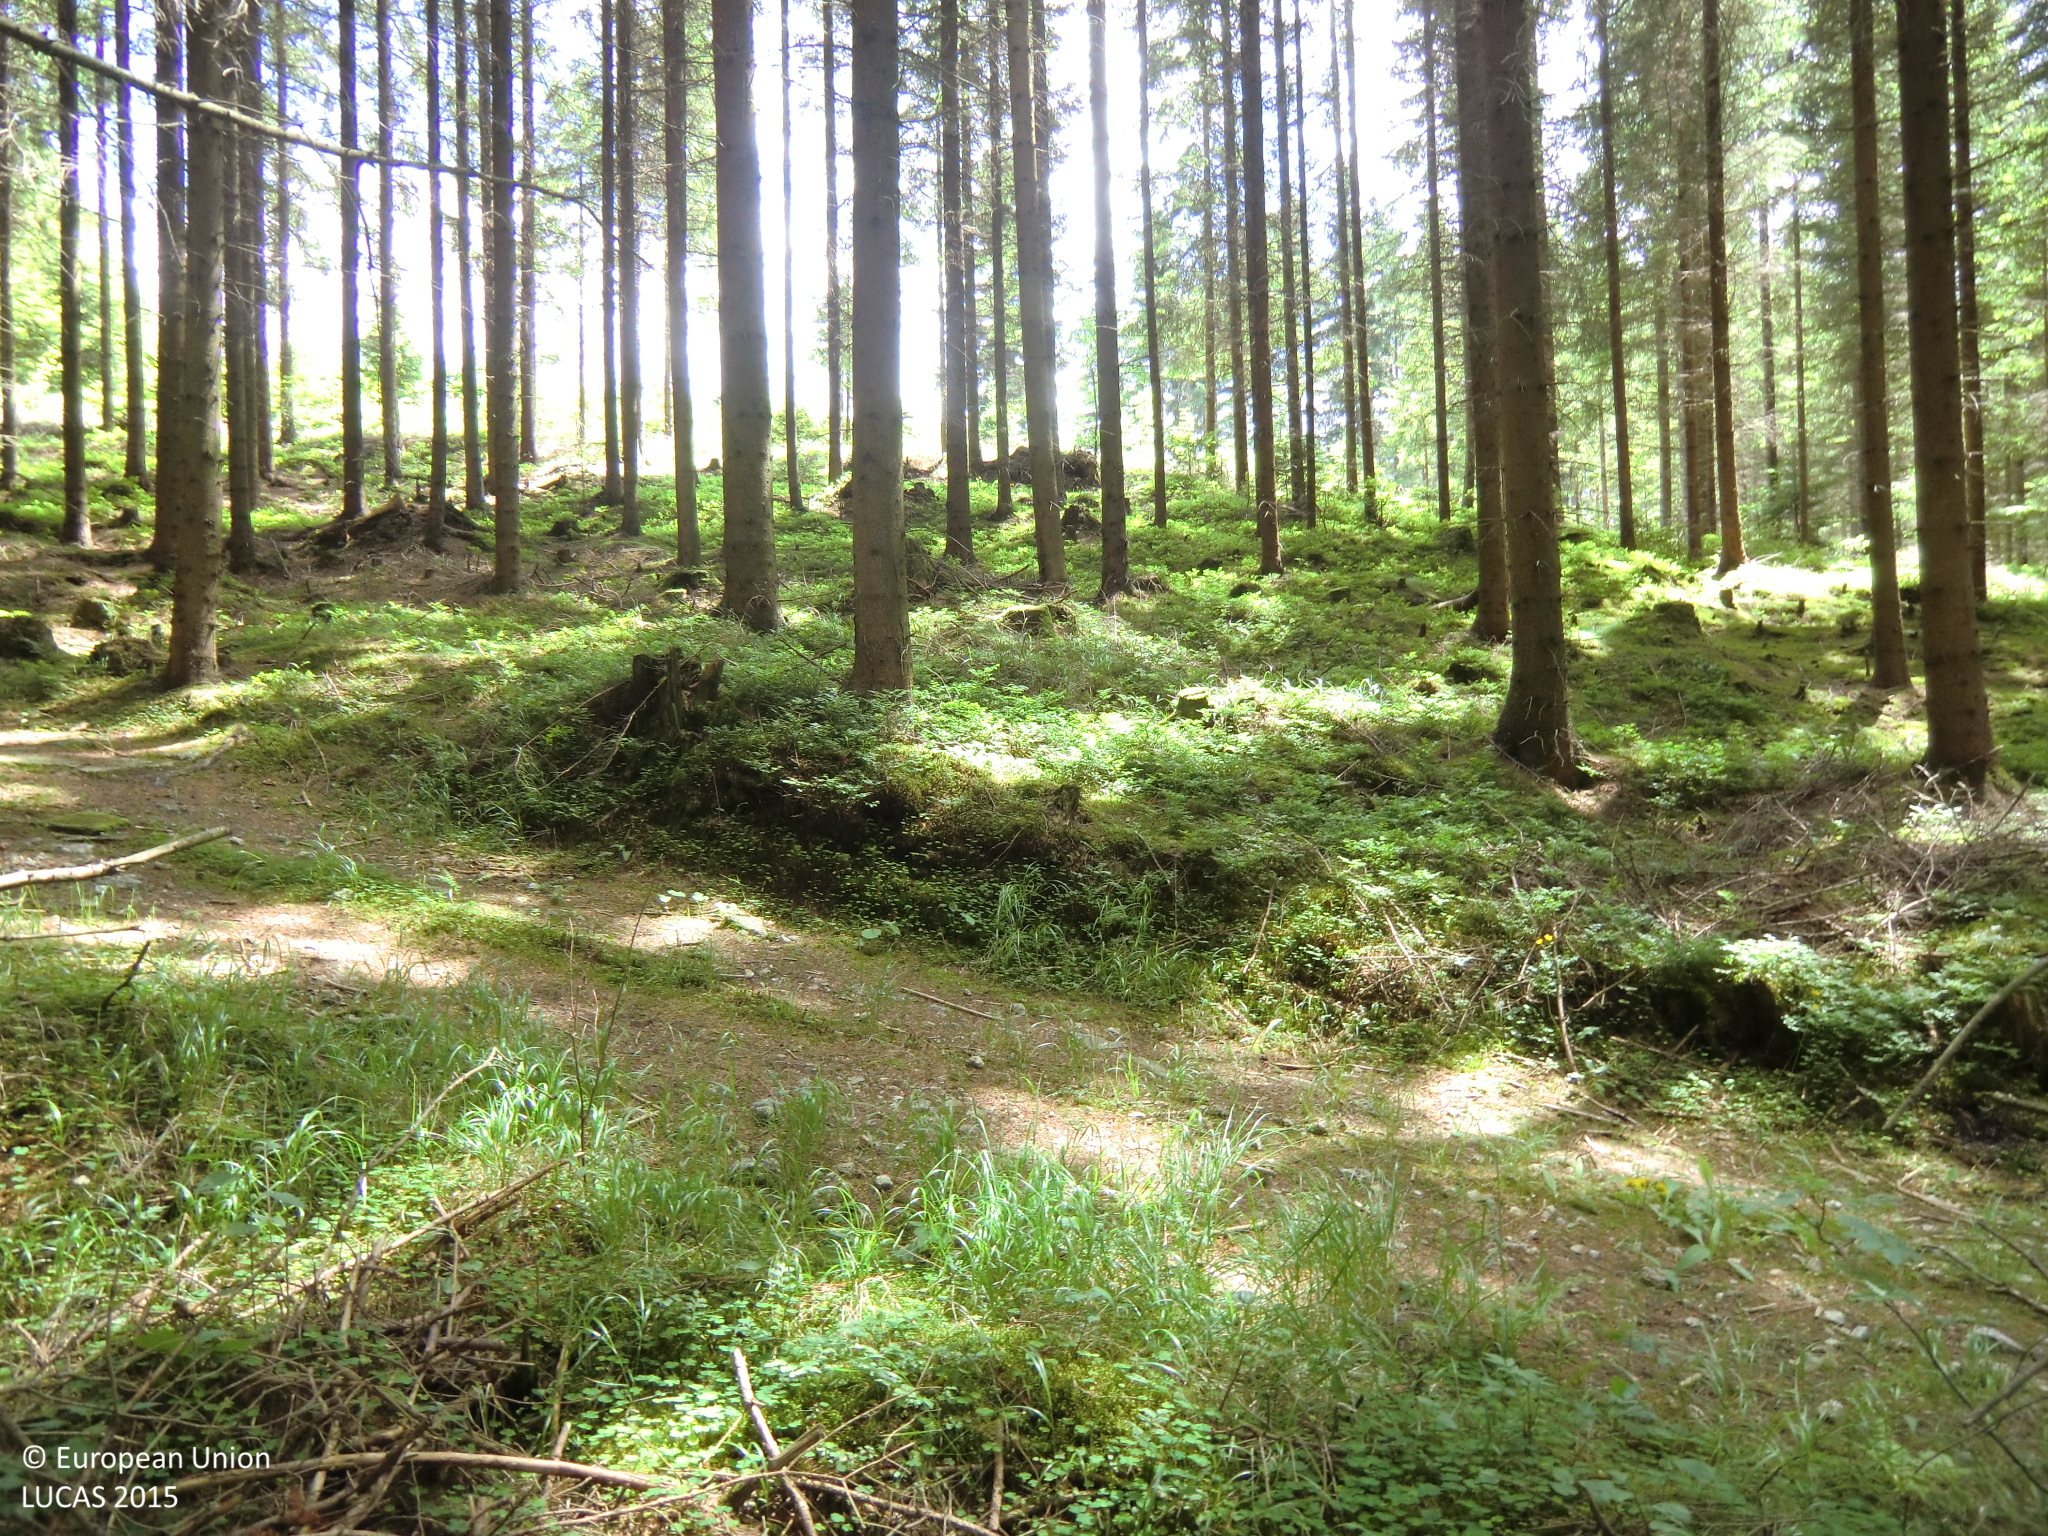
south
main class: Woodland
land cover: Spruce dominated coniferous woodland
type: hemiboreal forest and nemoral coniferous forest and mixed broadleaved-coniferous forest
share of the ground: > 75 %
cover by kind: coniferous forest trees 80 %, shrubs 10 %, herbaceous plants 10 %
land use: Forestry
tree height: > 5 m
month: June
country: AT
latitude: 48.5309
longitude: 14.8629
